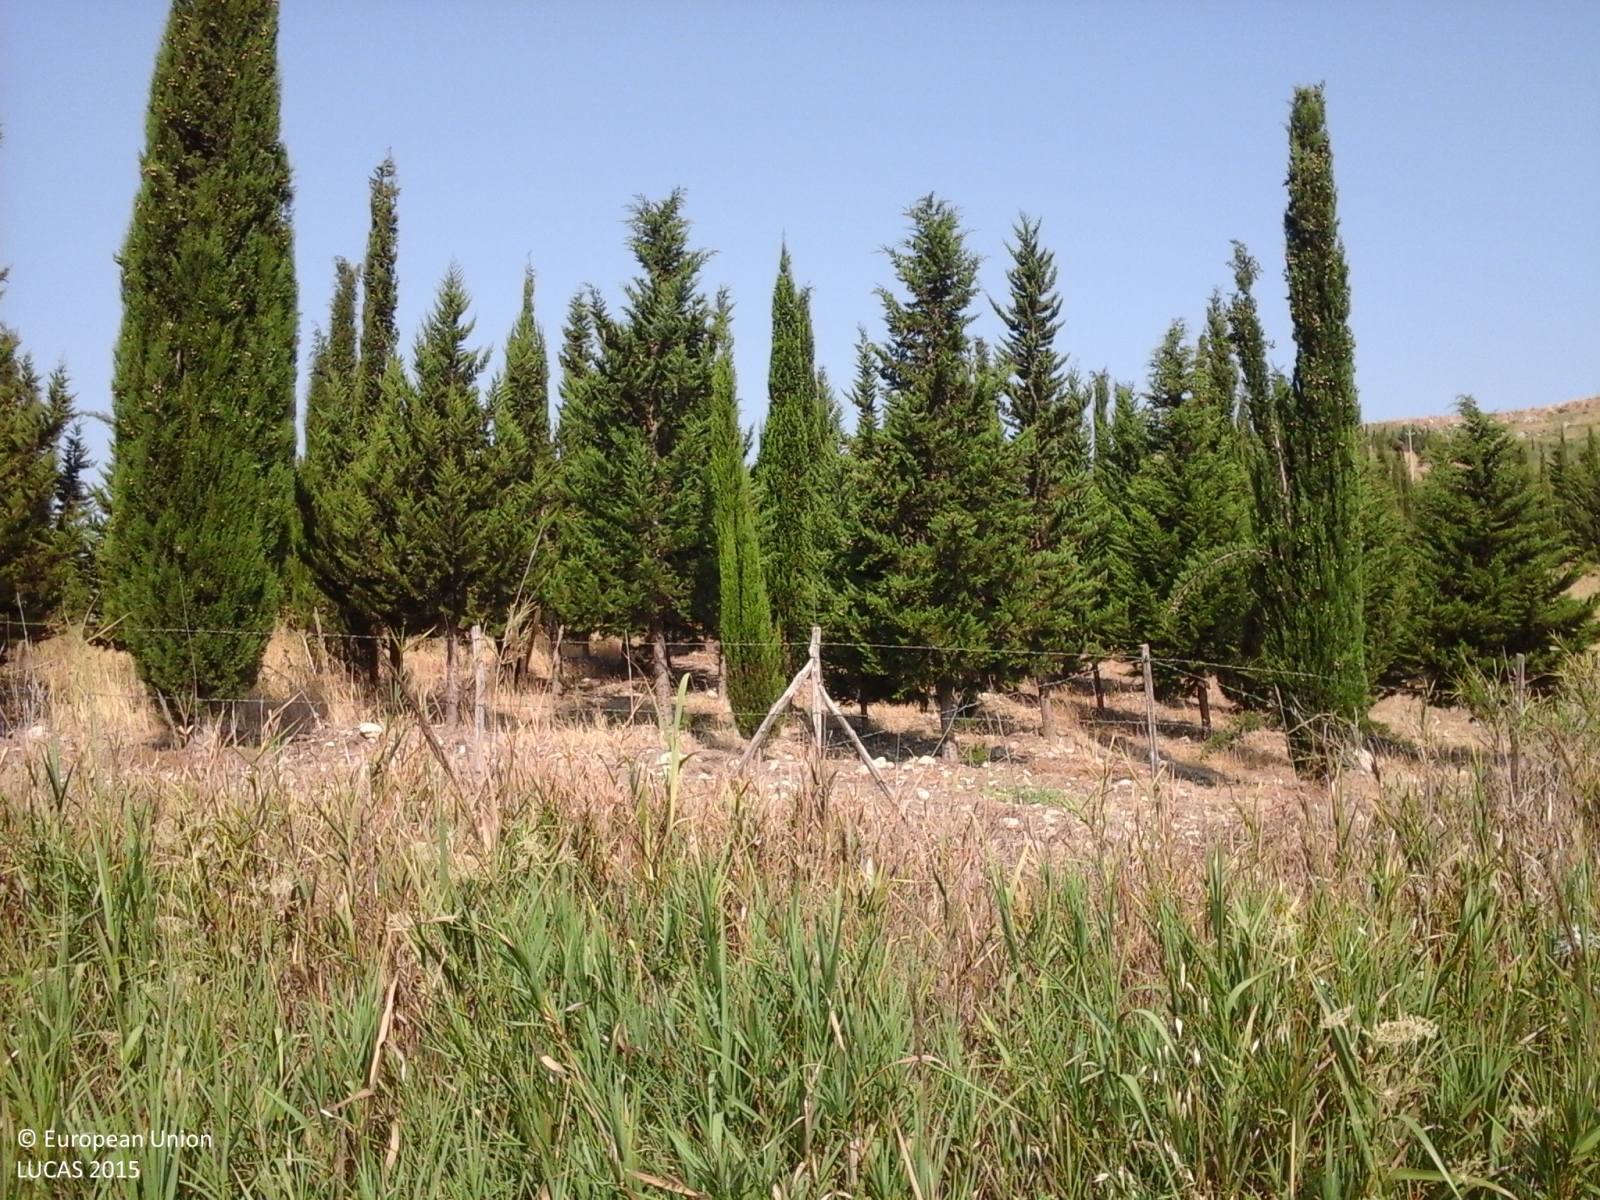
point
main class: Woodland
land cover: Other coniferous woodland
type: coniferous forest of the mediterranean region
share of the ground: > 75 %
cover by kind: coniferous forest trees 100 %
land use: Semi-natural and natural areas not in use
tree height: > 5 m
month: July
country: IT
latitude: 37.2084
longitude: 14.0138
